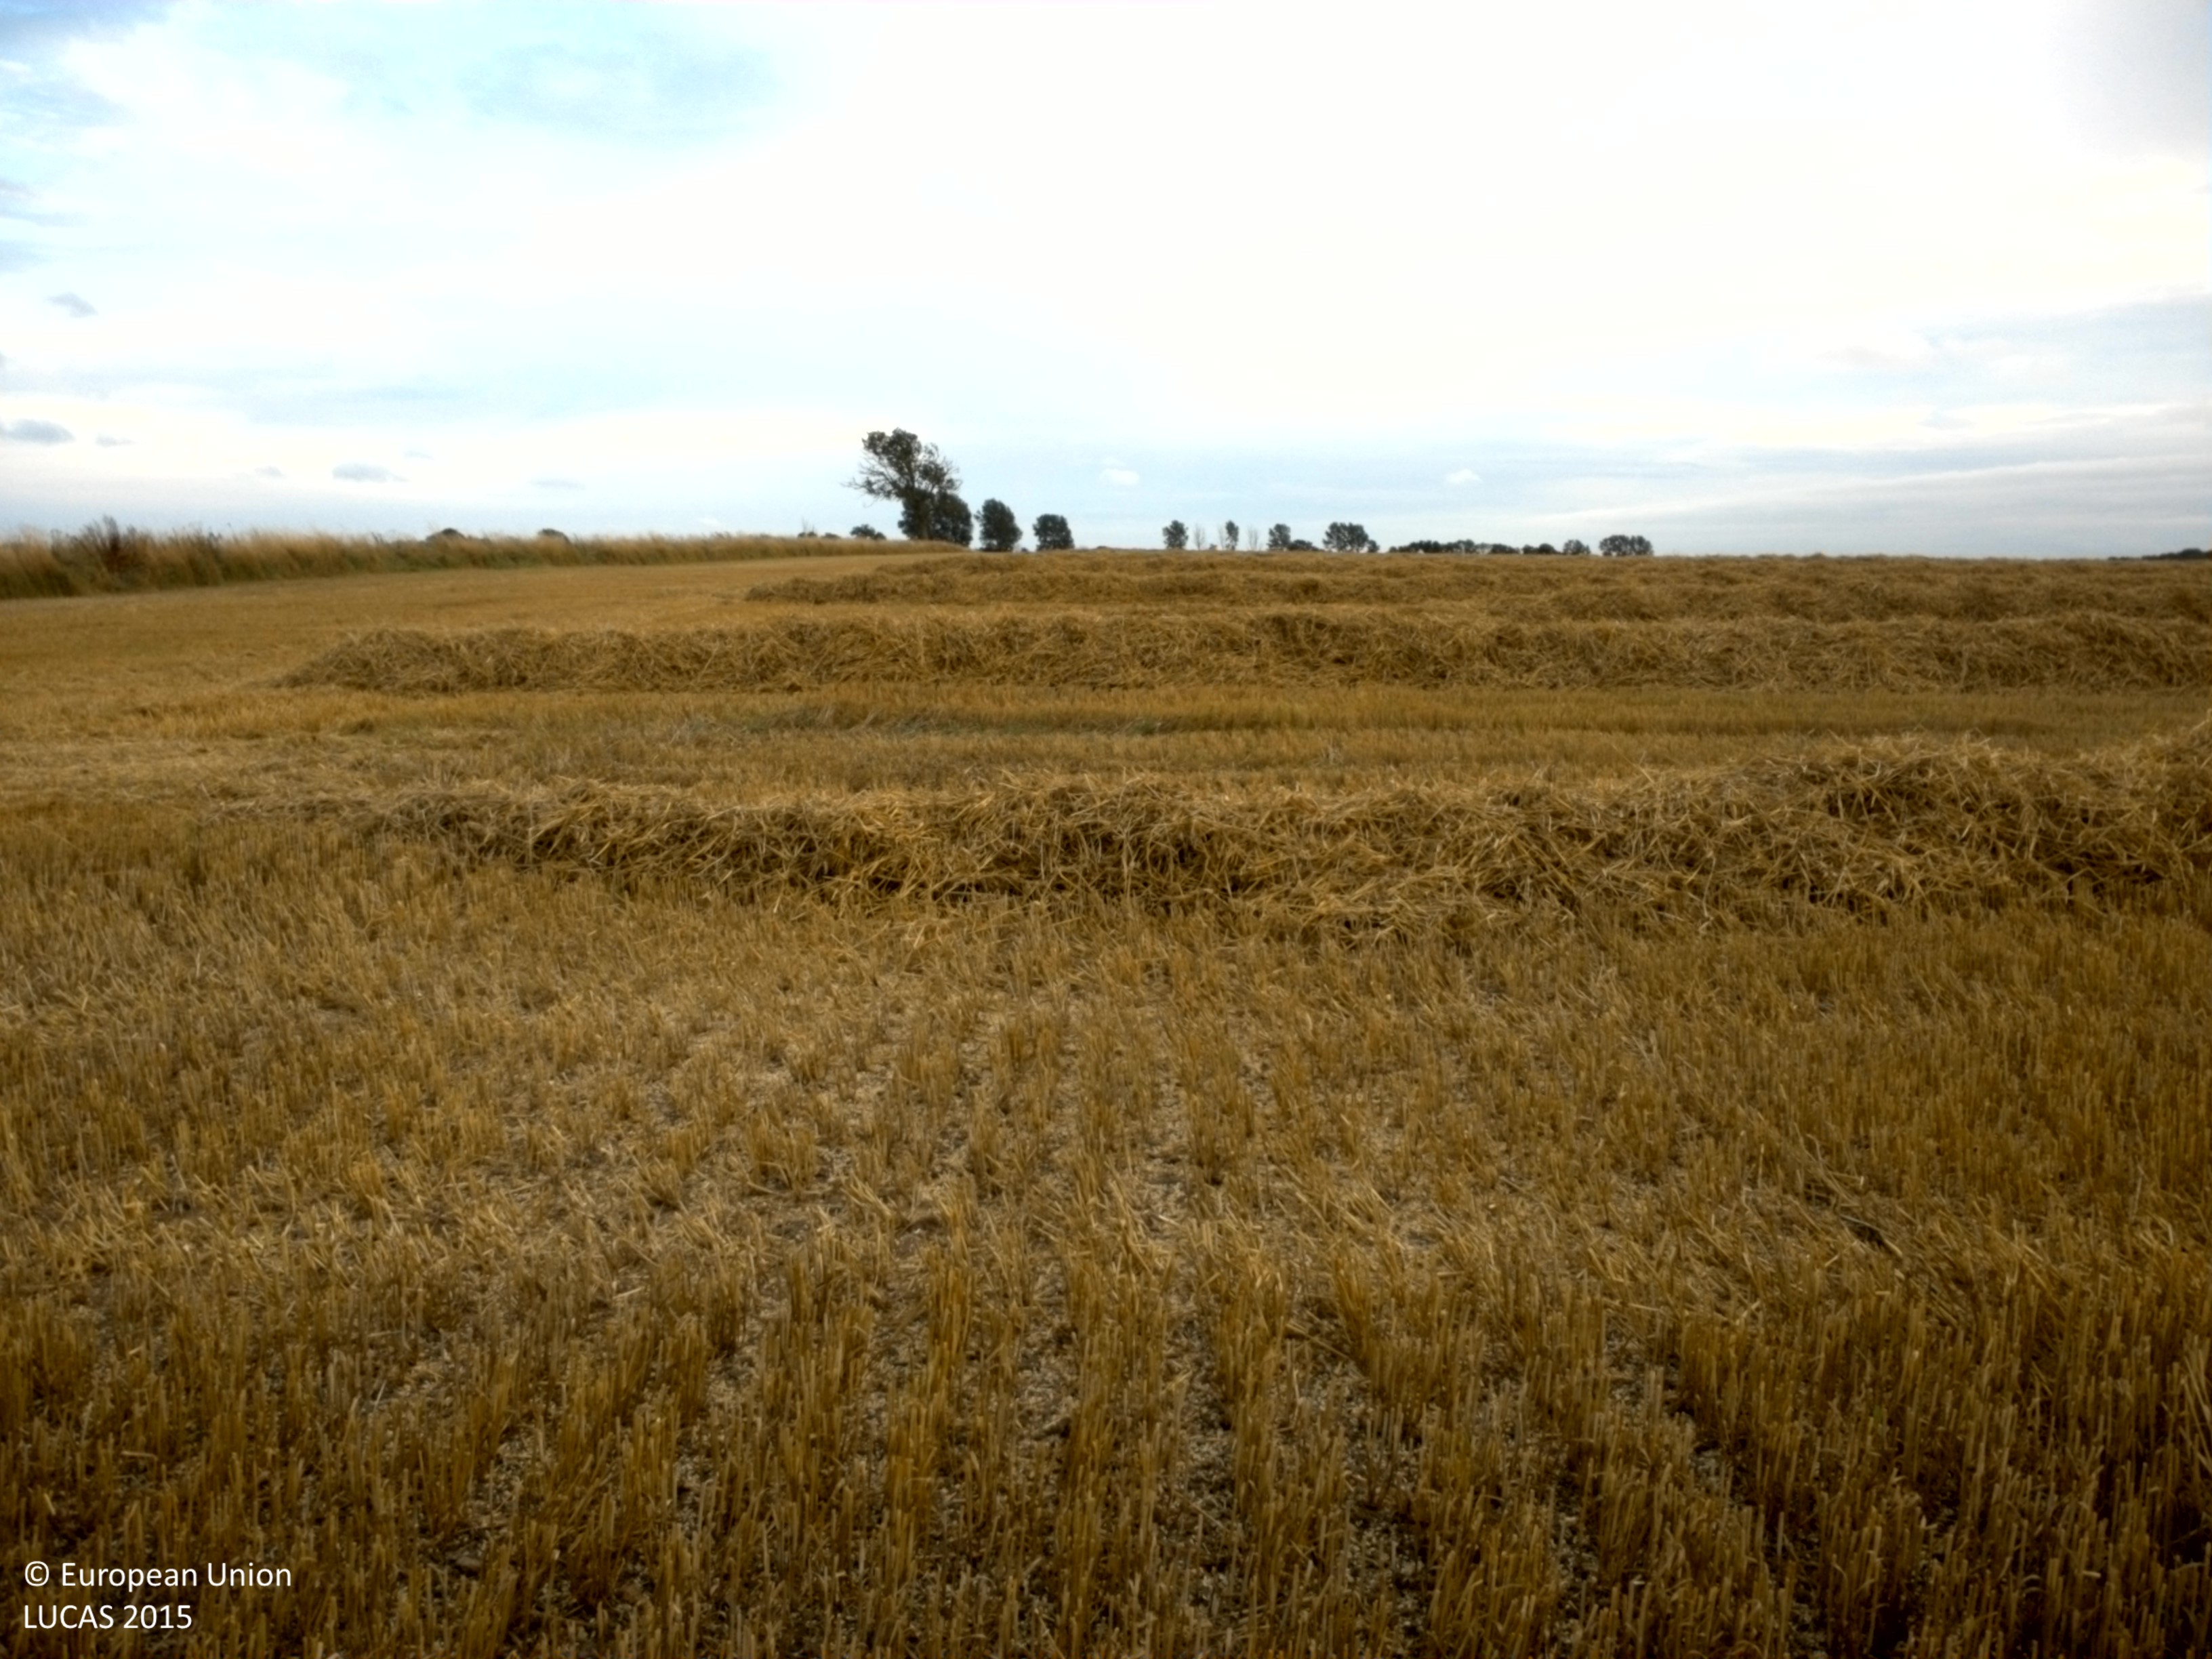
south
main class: Cropland
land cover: Common wheat
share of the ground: 25 - 50 %
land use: Agriculture (excluding fallow land and kitchen gardens)
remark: Harvested field
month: September
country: SE
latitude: 55.5040
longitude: 14.2894
